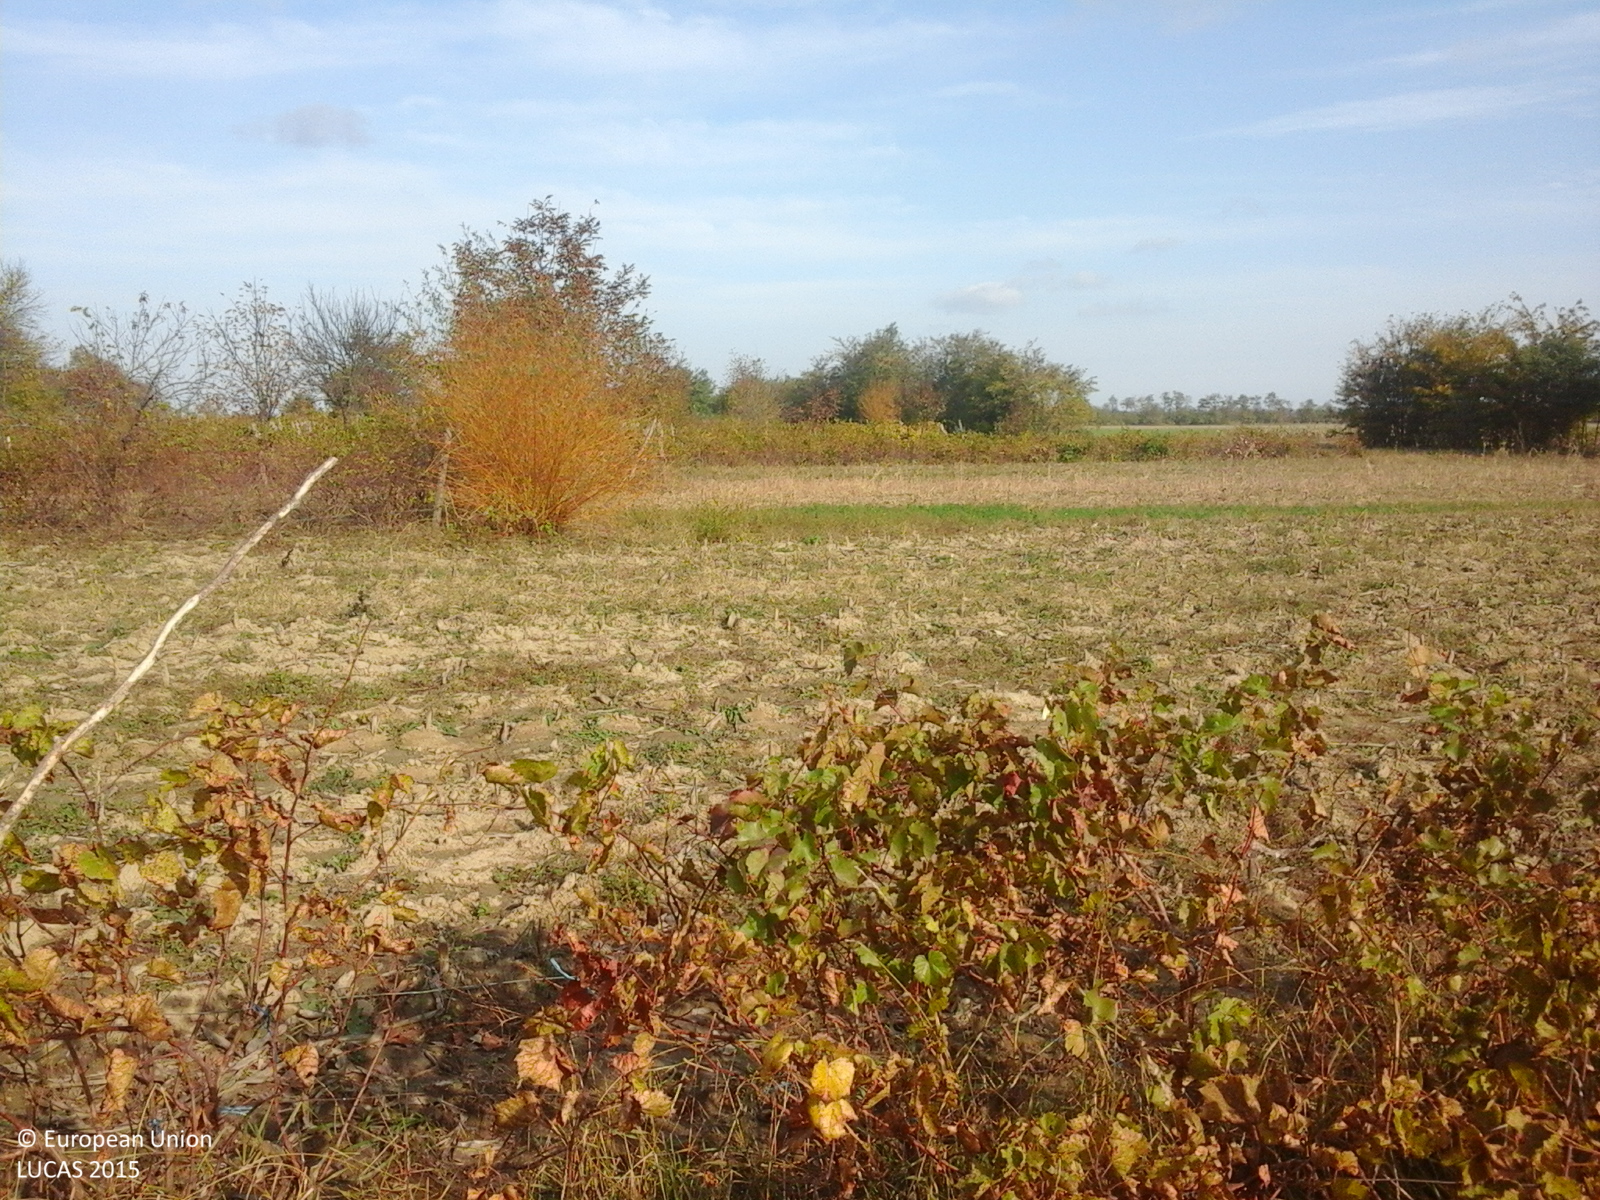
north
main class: Cropland
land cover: Vineyards
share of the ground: > 75 %
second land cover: Spontaneously vegetated surfaces
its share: 50 - 75 %
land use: Agriculture (excluding fallow land and kitchen gardens)
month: October
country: RO
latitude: 45.5101
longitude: 27.3392
